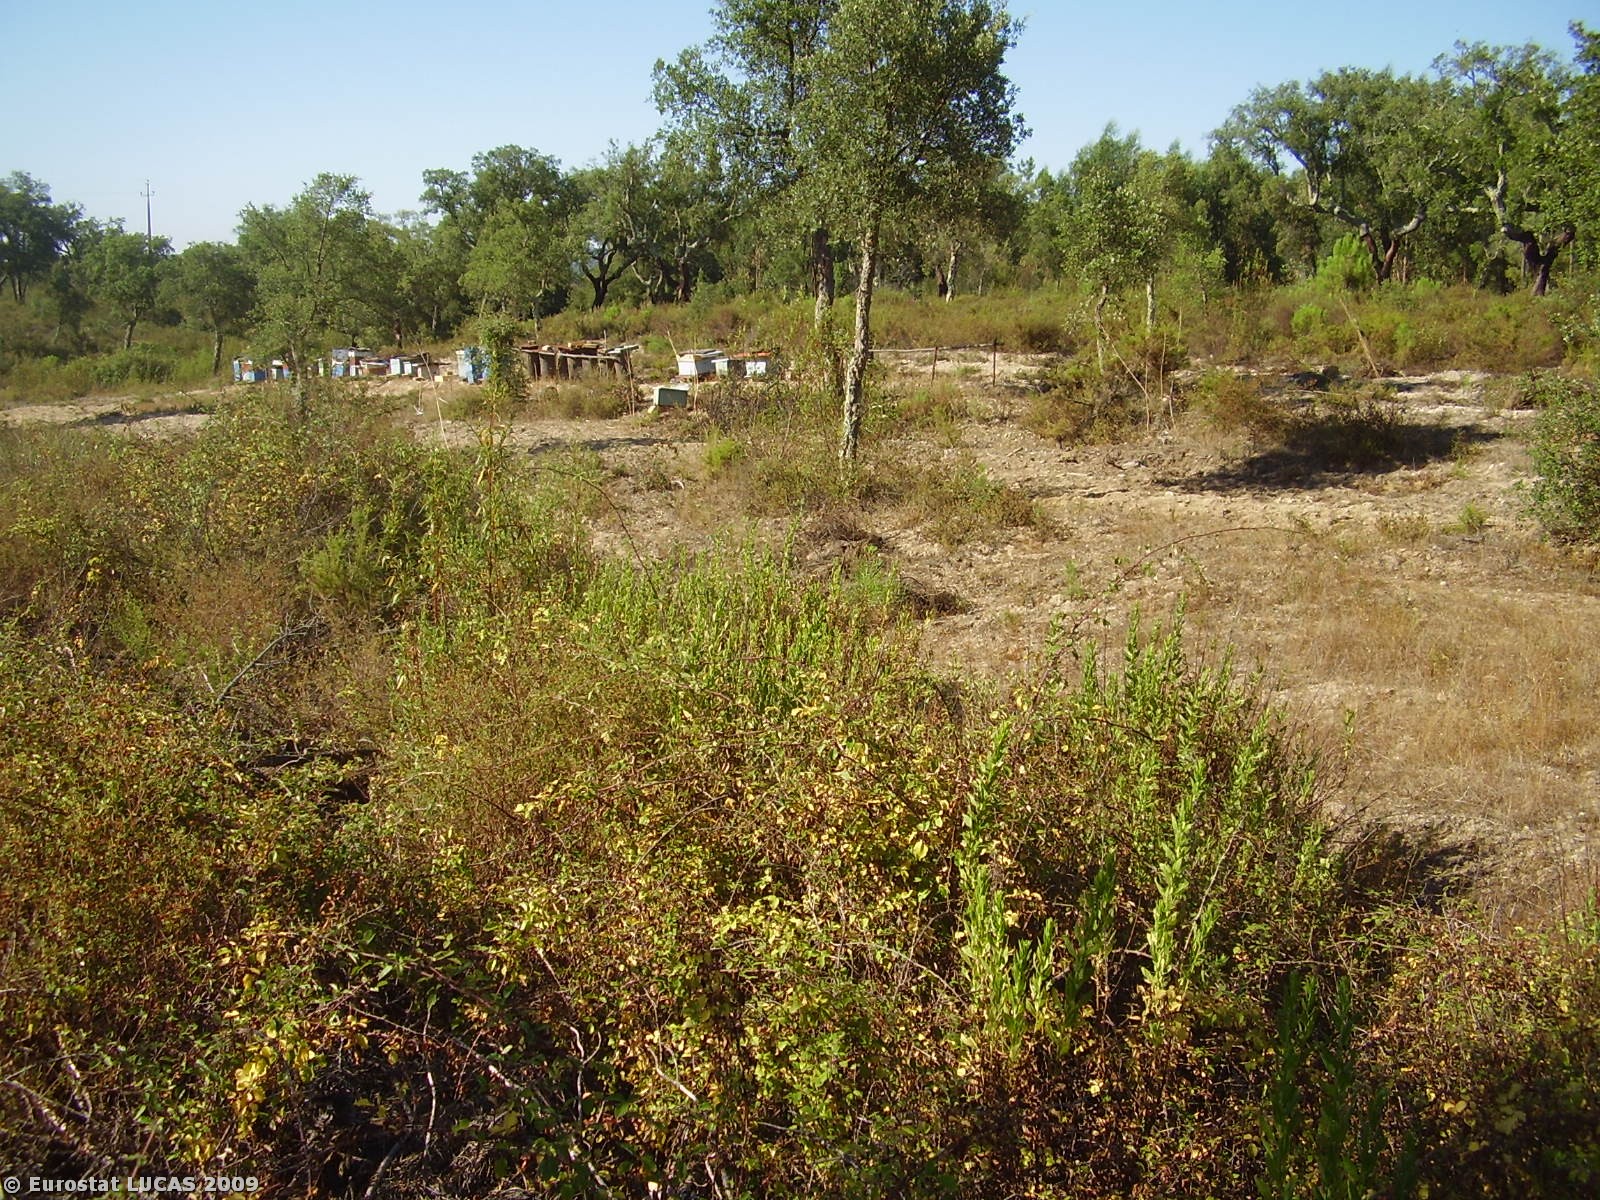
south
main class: Woodland
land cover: Broadleaved woodland
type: broadleaved evergreen forest
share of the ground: 10 - 25 %
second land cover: Shrubland with sparse tree cover
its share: 50 - 75 %
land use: Forestry
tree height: > 5 m
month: July
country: PT
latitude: 39.3483
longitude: -8.0791
